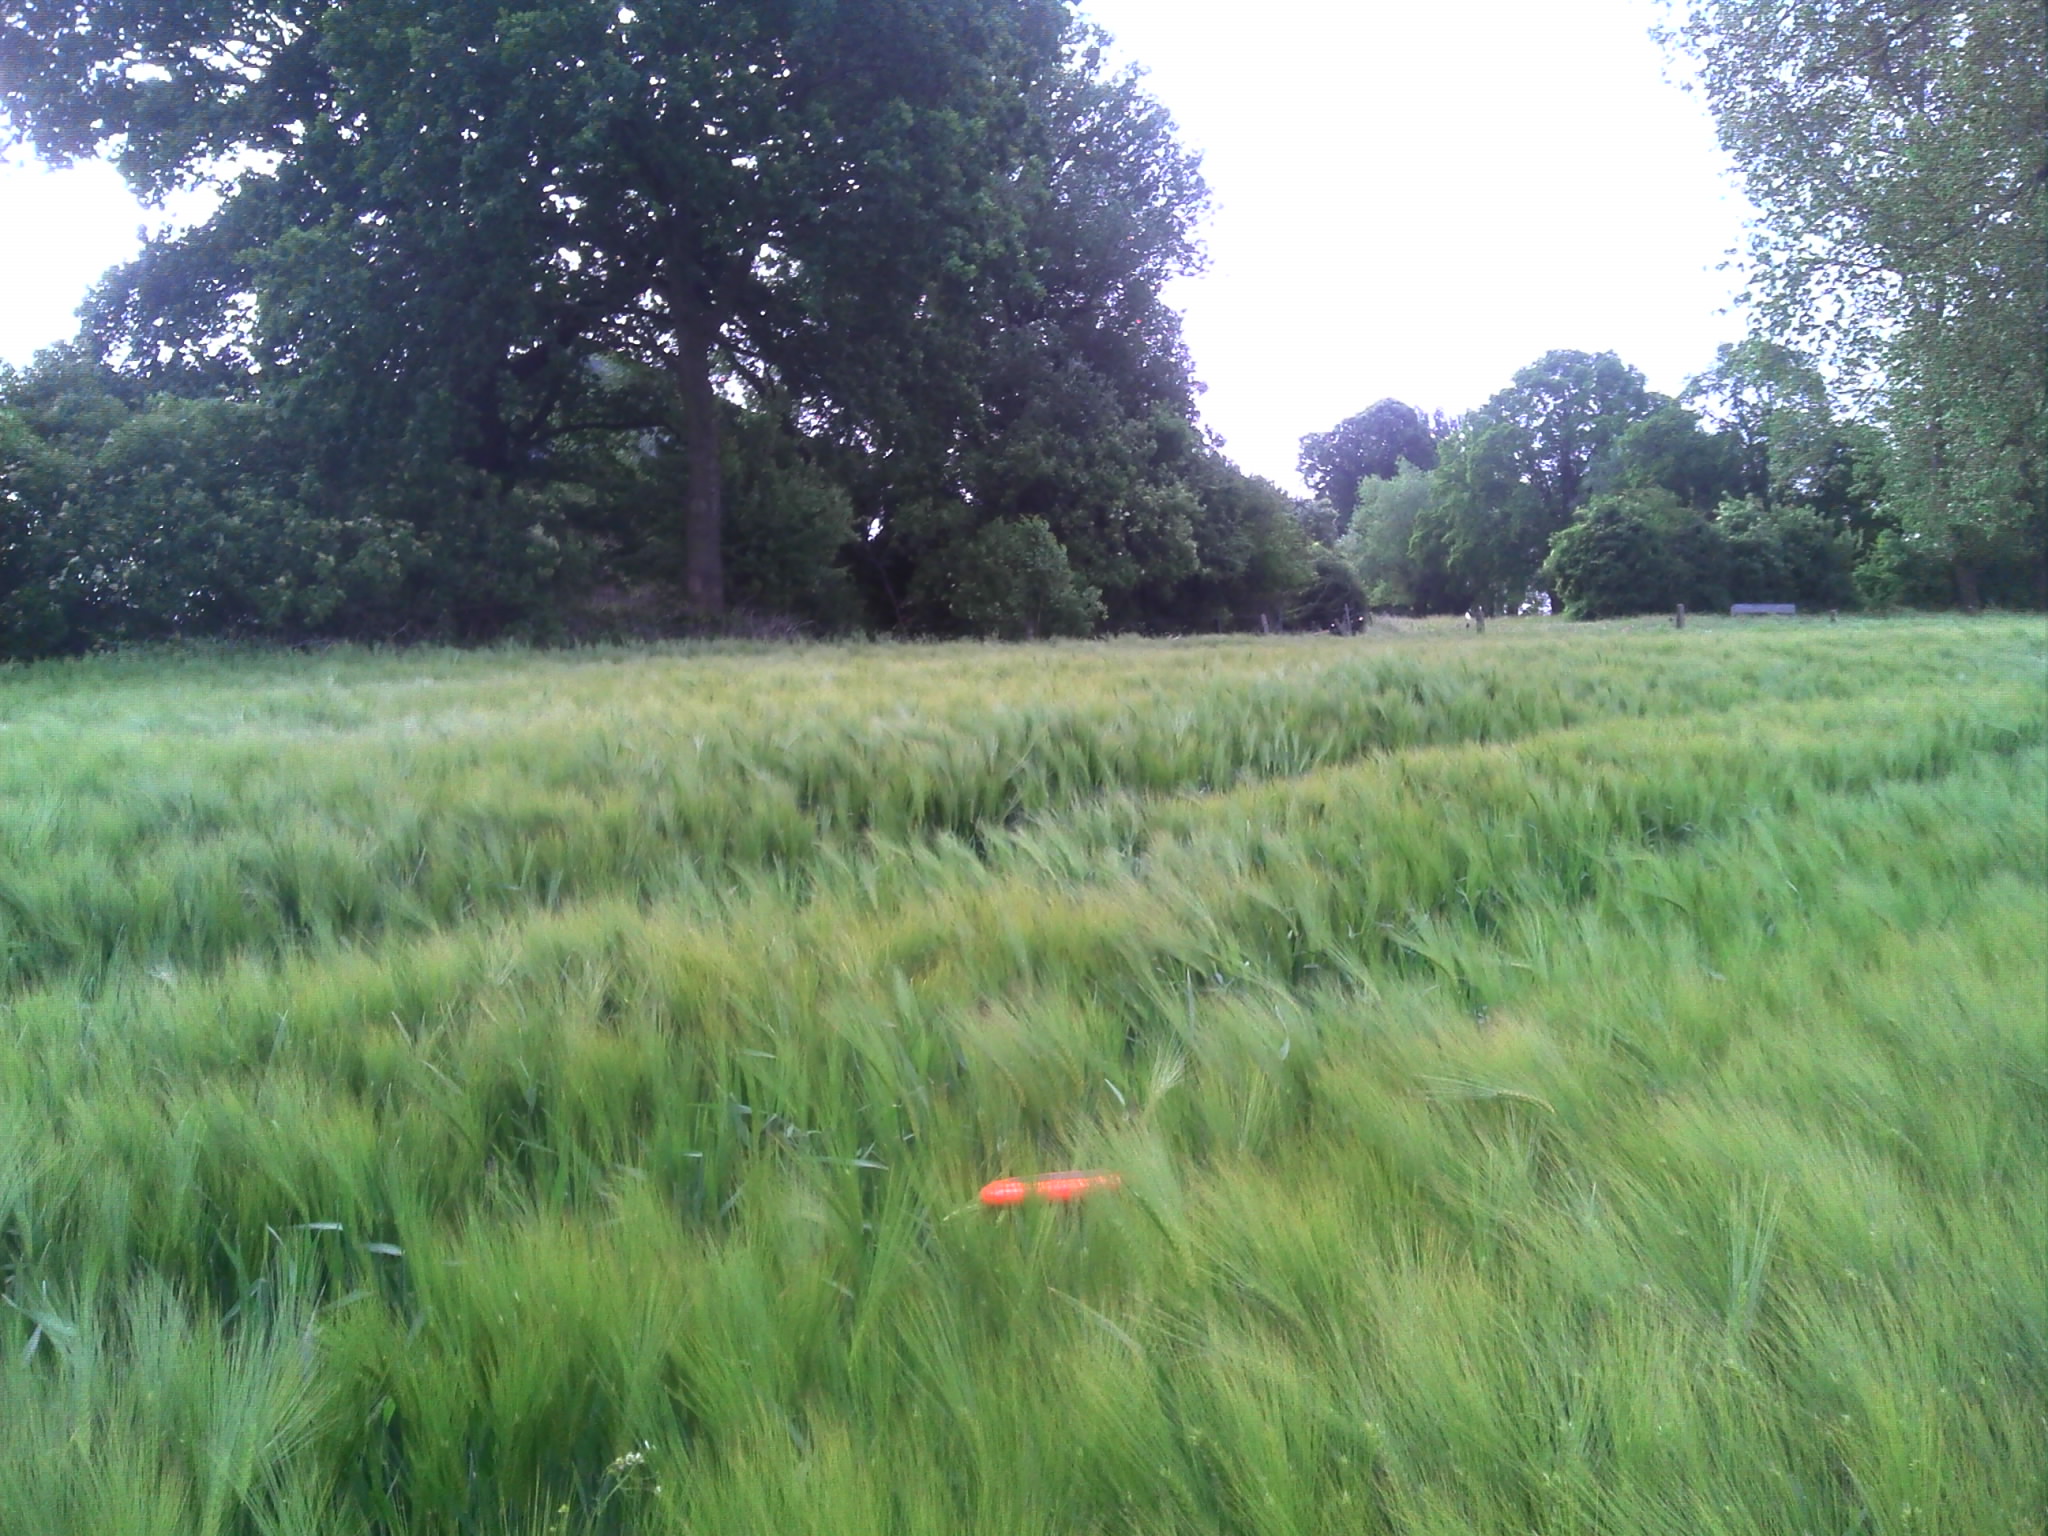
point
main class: Cropland
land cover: Barley
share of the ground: > 75 %
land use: Agriculture (excluding fallow land and kitchen gardens)
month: June
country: BE
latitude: 50.5425
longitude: 4.5916
